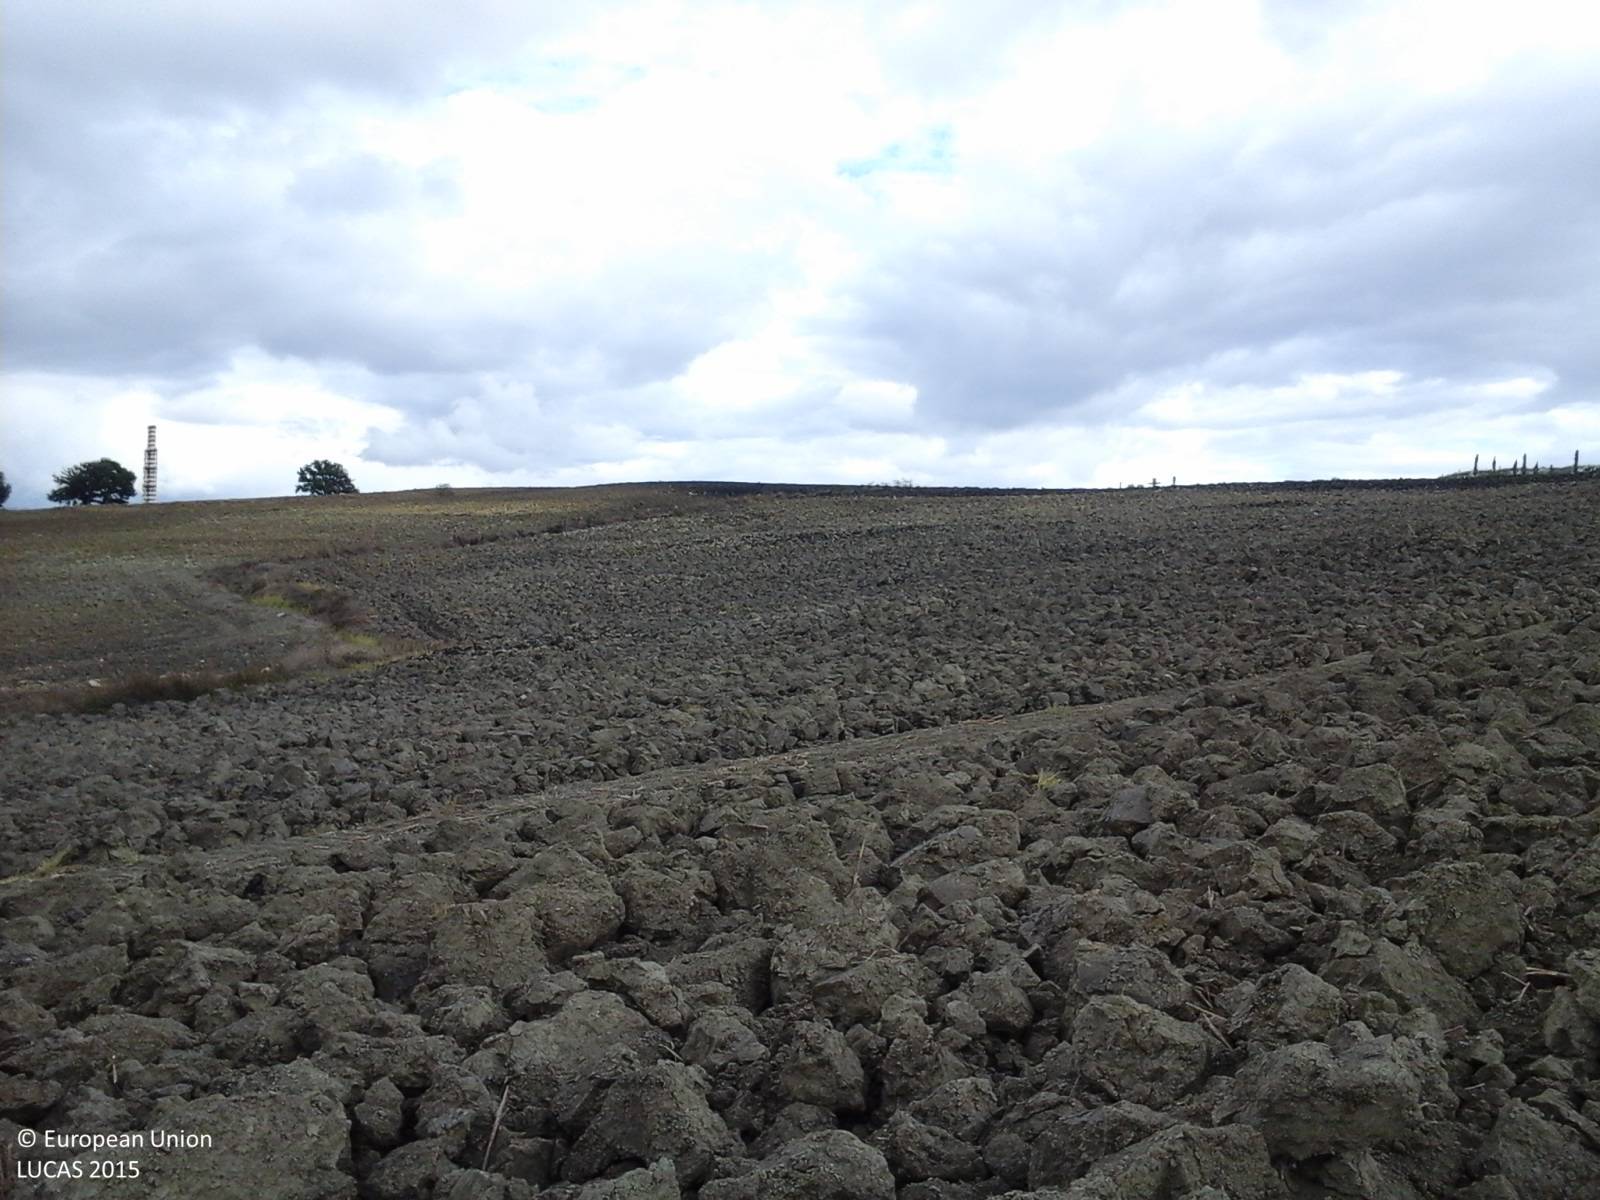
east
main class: Cropland
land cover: Sunflower
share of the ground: > 75 %
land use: Agriculture (excluding fallow land and kitchen gardens)
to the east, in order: Sunflower; Shruby margins; Ditches and canals; Shruby margins; Sunflower; Ditches and canals; Durum wheat
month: September
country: IT
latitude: 42.8935
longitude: 12.5272
